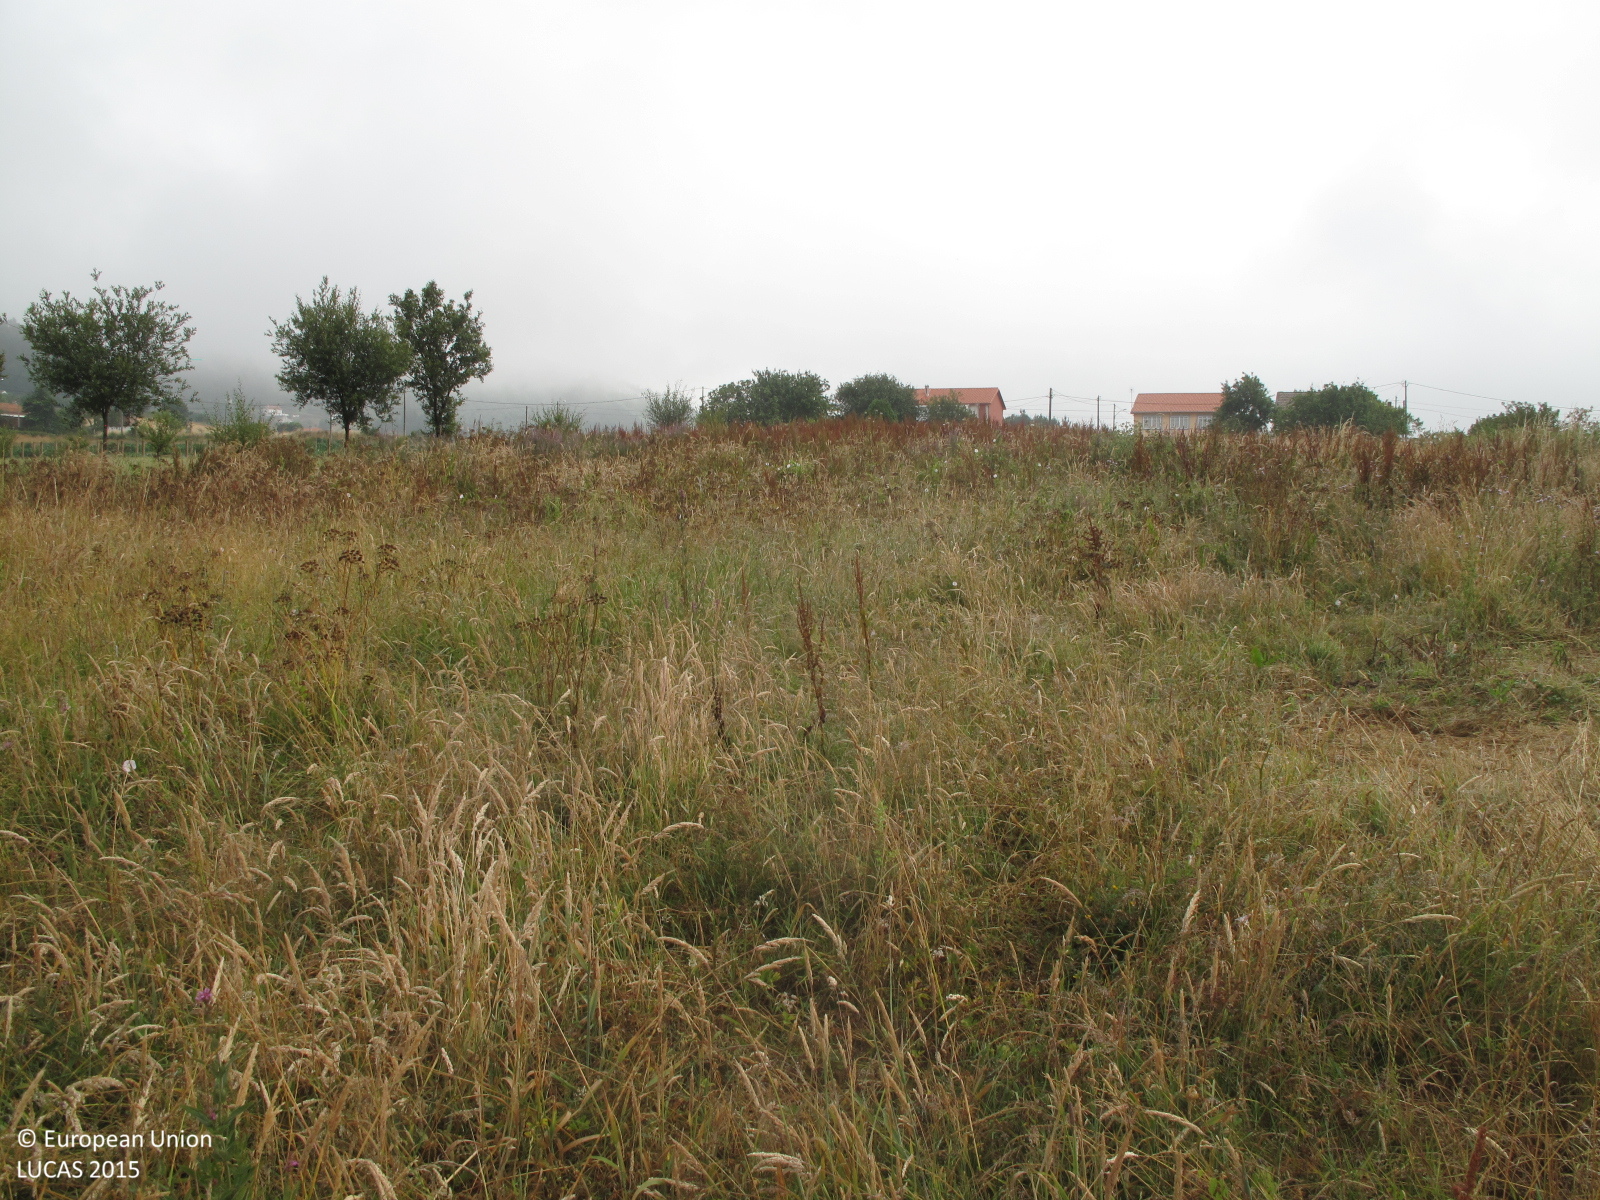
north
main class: Grassland
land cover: Grassland without tree/shrub cover
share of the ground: > 75 %
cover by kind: herbaceous plants 100 %
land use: Agriculture (excluding fallow land and kitchen gardens)
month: July
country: ES
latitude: 43.5307
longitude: -8.2310
